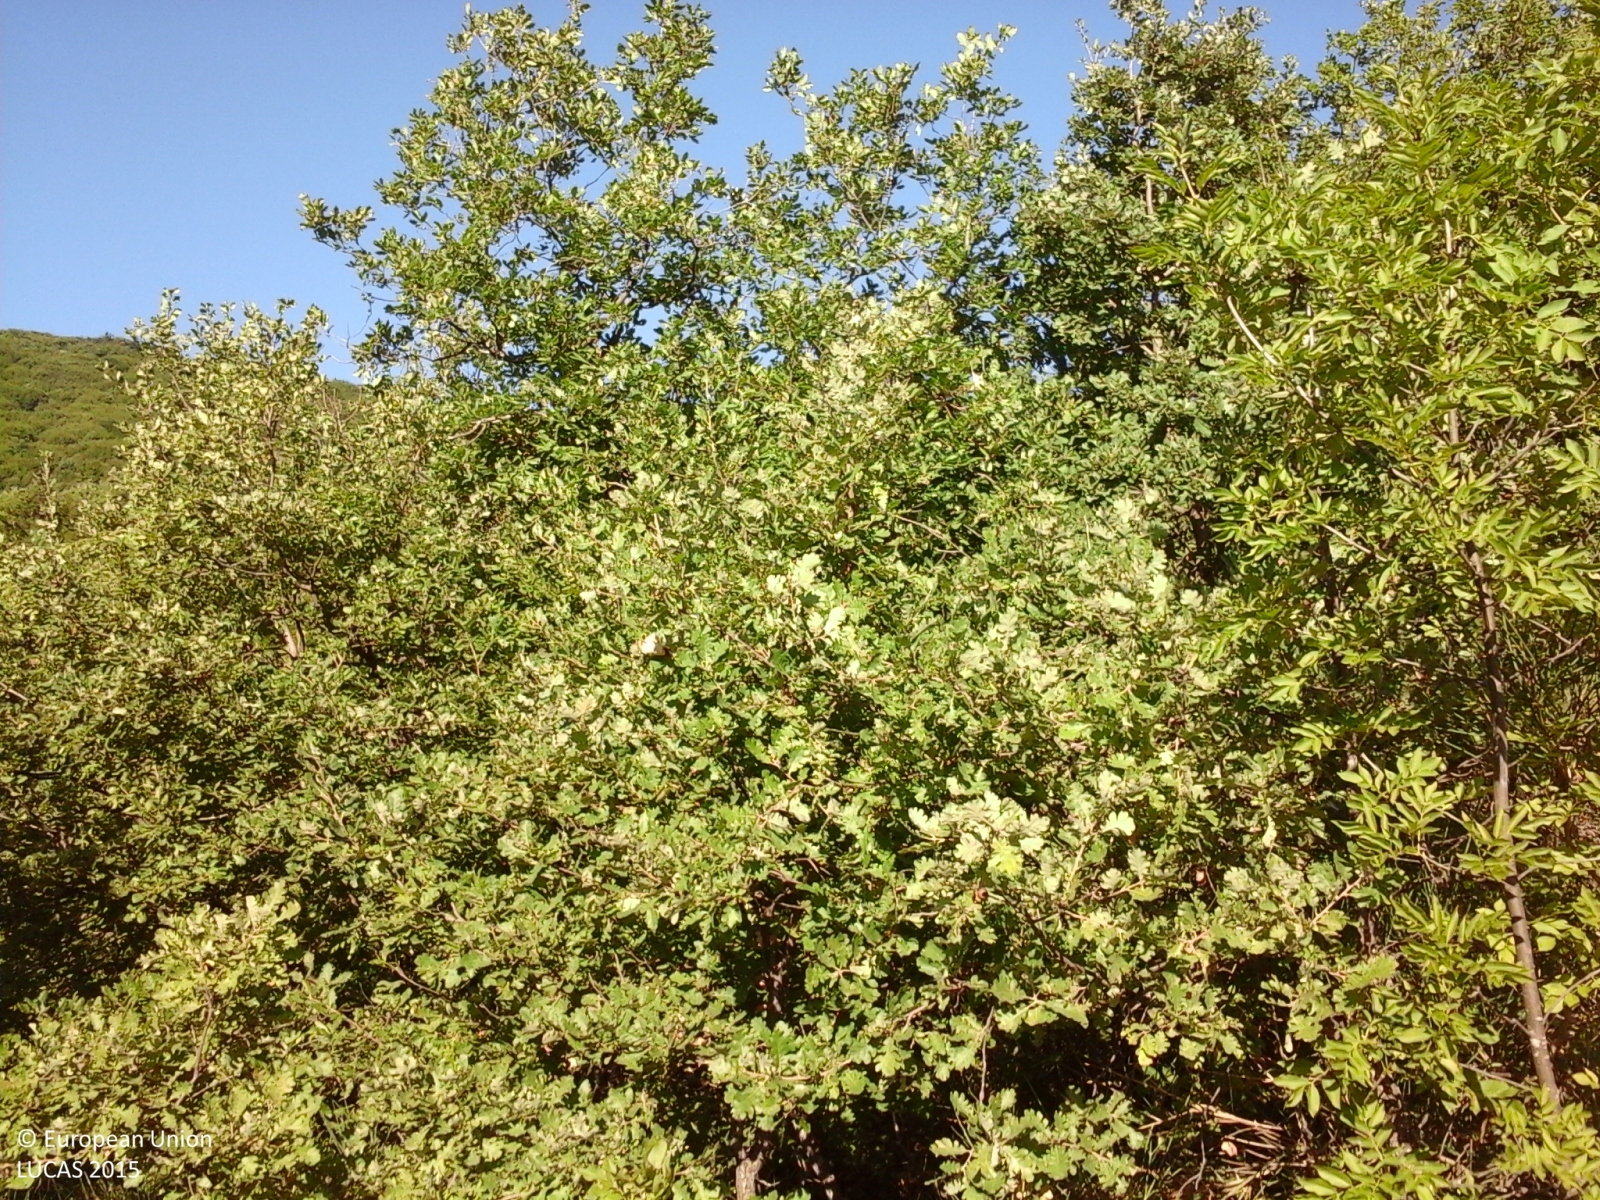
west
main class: Woodland
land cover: Broadleaved woodland
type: thermophilous deciduous forest
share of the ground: > 75 %
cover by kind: broadleaved forest trees 95 %, coniferous forest trees 5 %
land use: Forestry
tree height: > 5 m
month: August
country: IT
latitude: 43.1515
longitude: 13.0045
